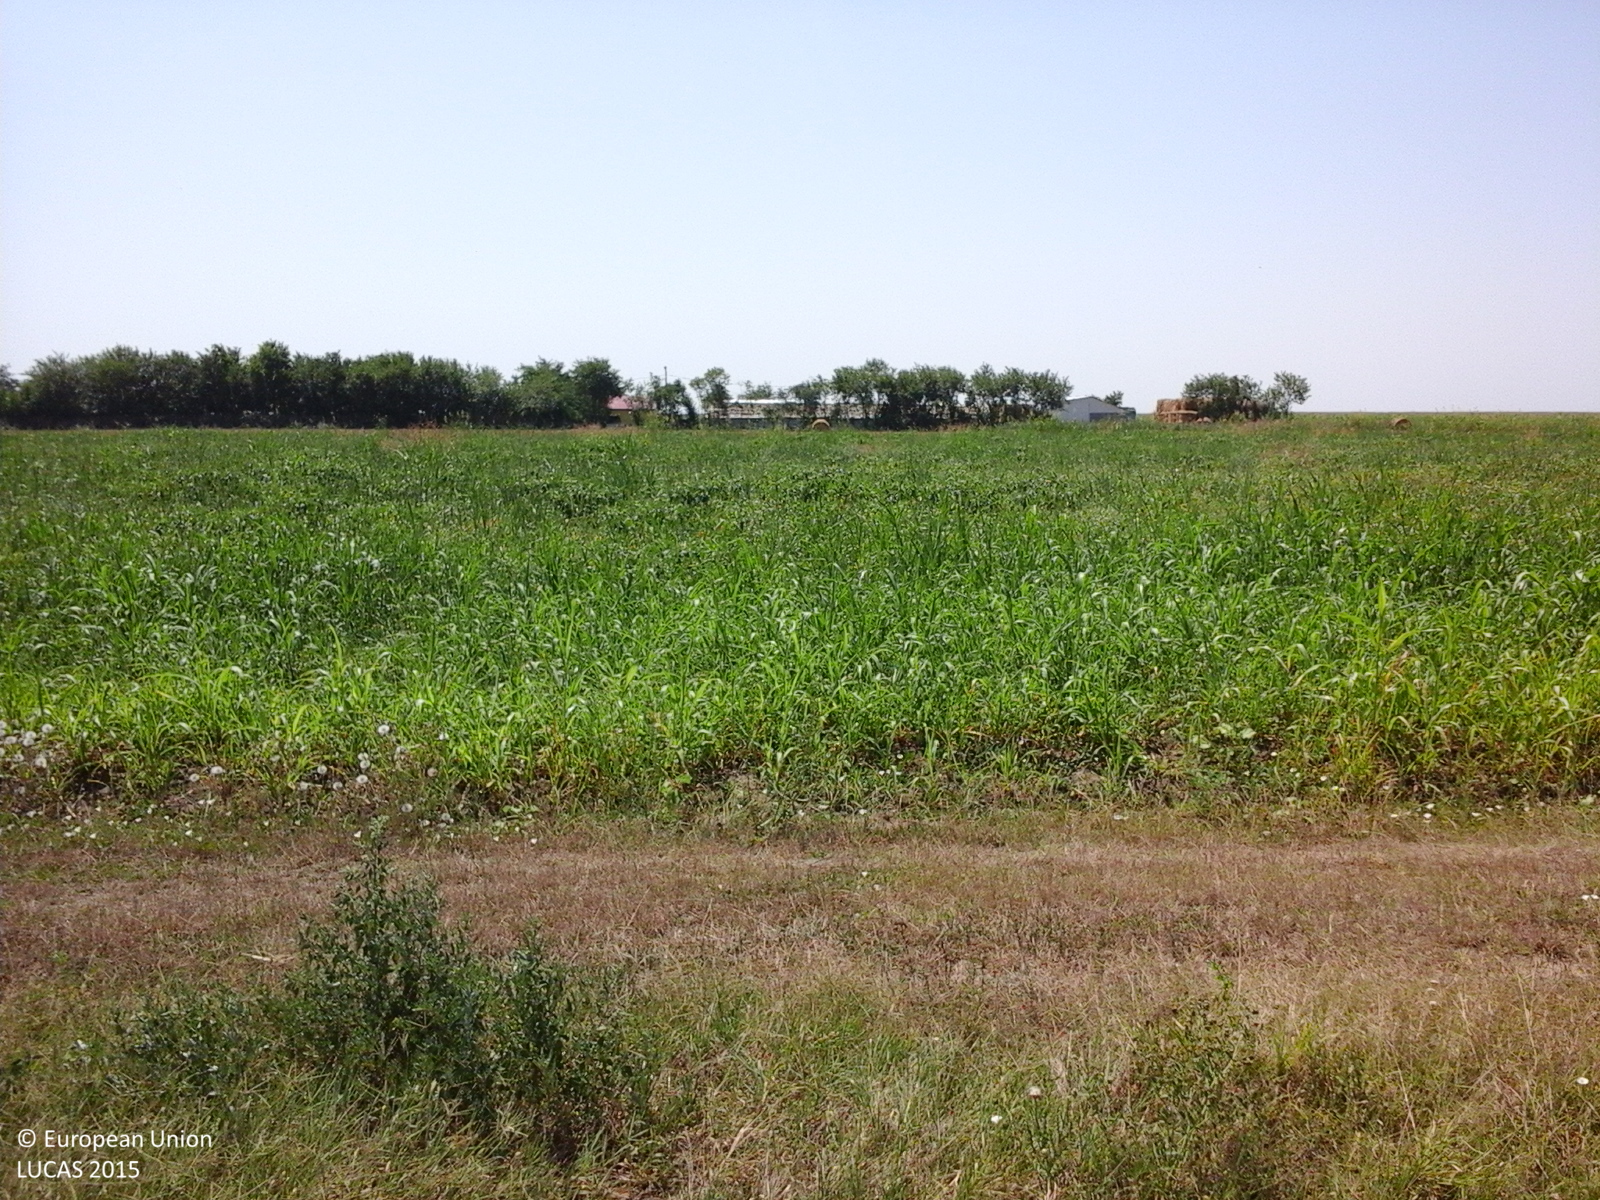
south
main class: Cropland
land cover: Lucerne
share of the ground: > 75 %
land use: Agriculture (excluding fallow land and kitchen gardens)
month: July
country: RO
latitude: 45.0517
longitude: 27.2186
